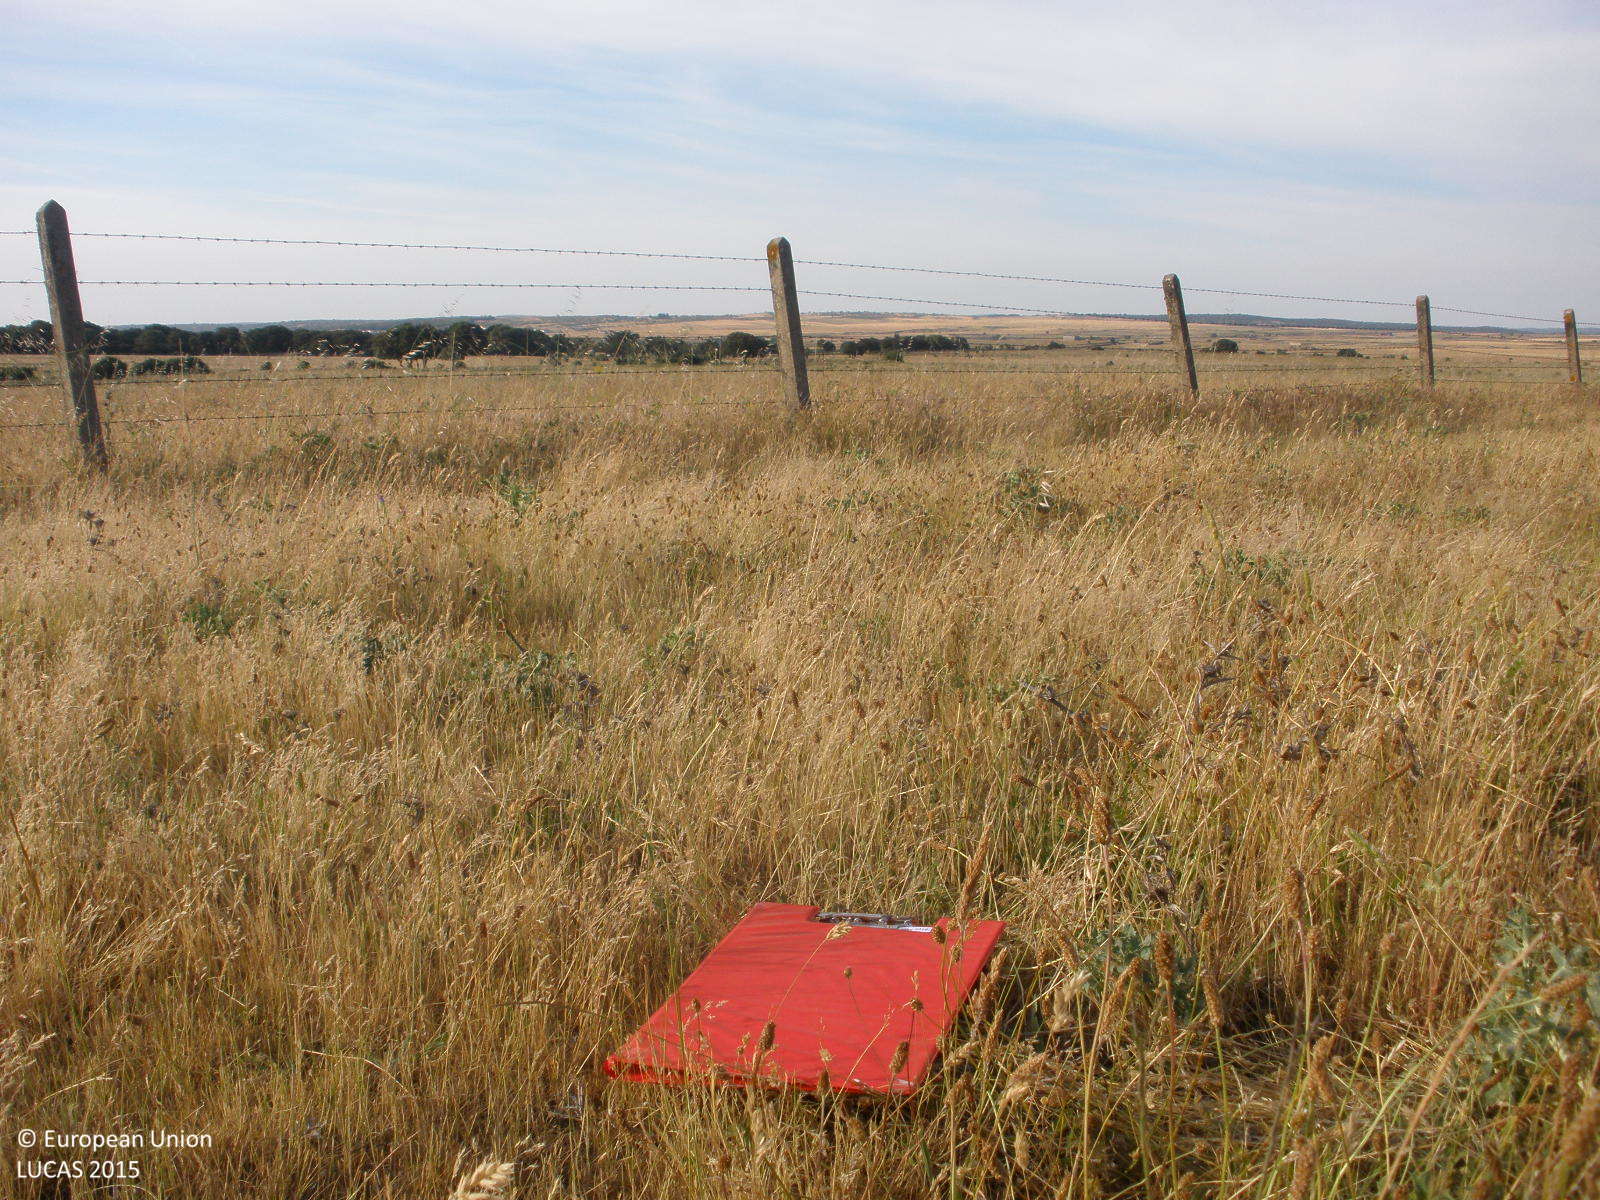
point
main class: Grassland
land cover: Grassland without tree/shrub cover
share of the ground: > 75 %
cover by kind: herbaceous plants 100 %
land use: Agriculture (excluding fallow land and kitchen gardens)
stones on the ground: 10 - 25 %
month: June
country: ES
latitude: 40.6957
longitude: -6.7469
